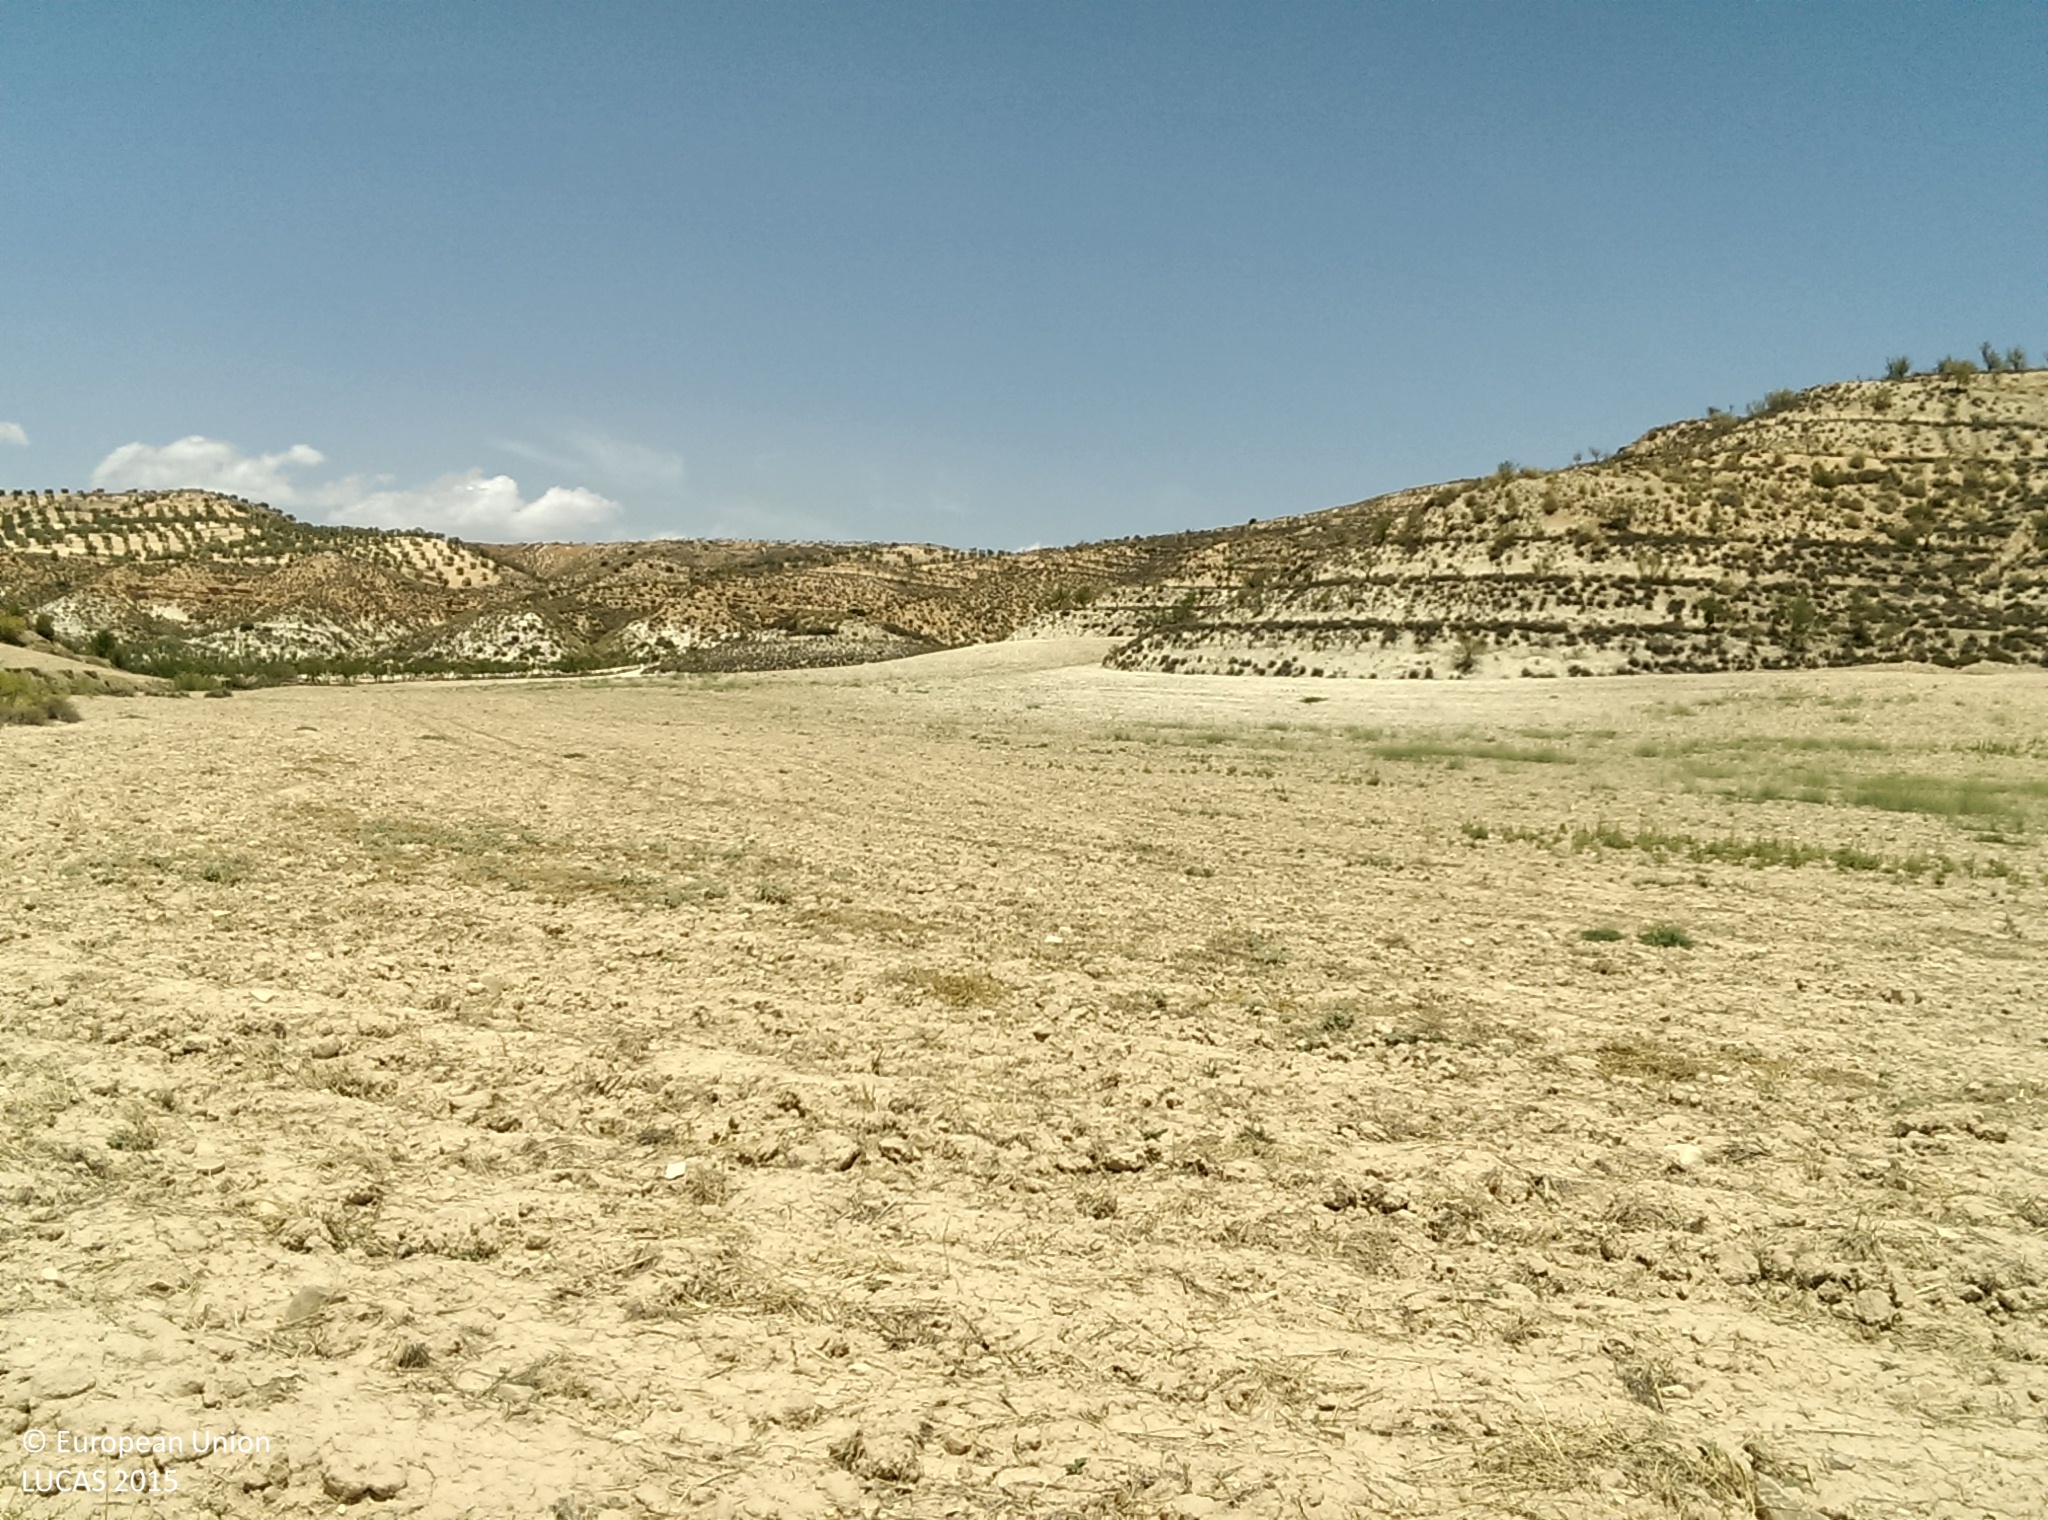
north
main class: Grassland
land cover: Grassland with sparse tree/shrub cover
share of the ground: 50 - 75 %
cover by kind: herbaceous plants 75 %, unconsolidated bare surface 15 %, broadleaved forest trees 5 %, shrubs 5 %
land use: Agriculture (excluding fallow land and kitchen gardens)
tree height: < 5 m
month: July
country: ES
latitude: 37.4401
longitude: -3.2480
